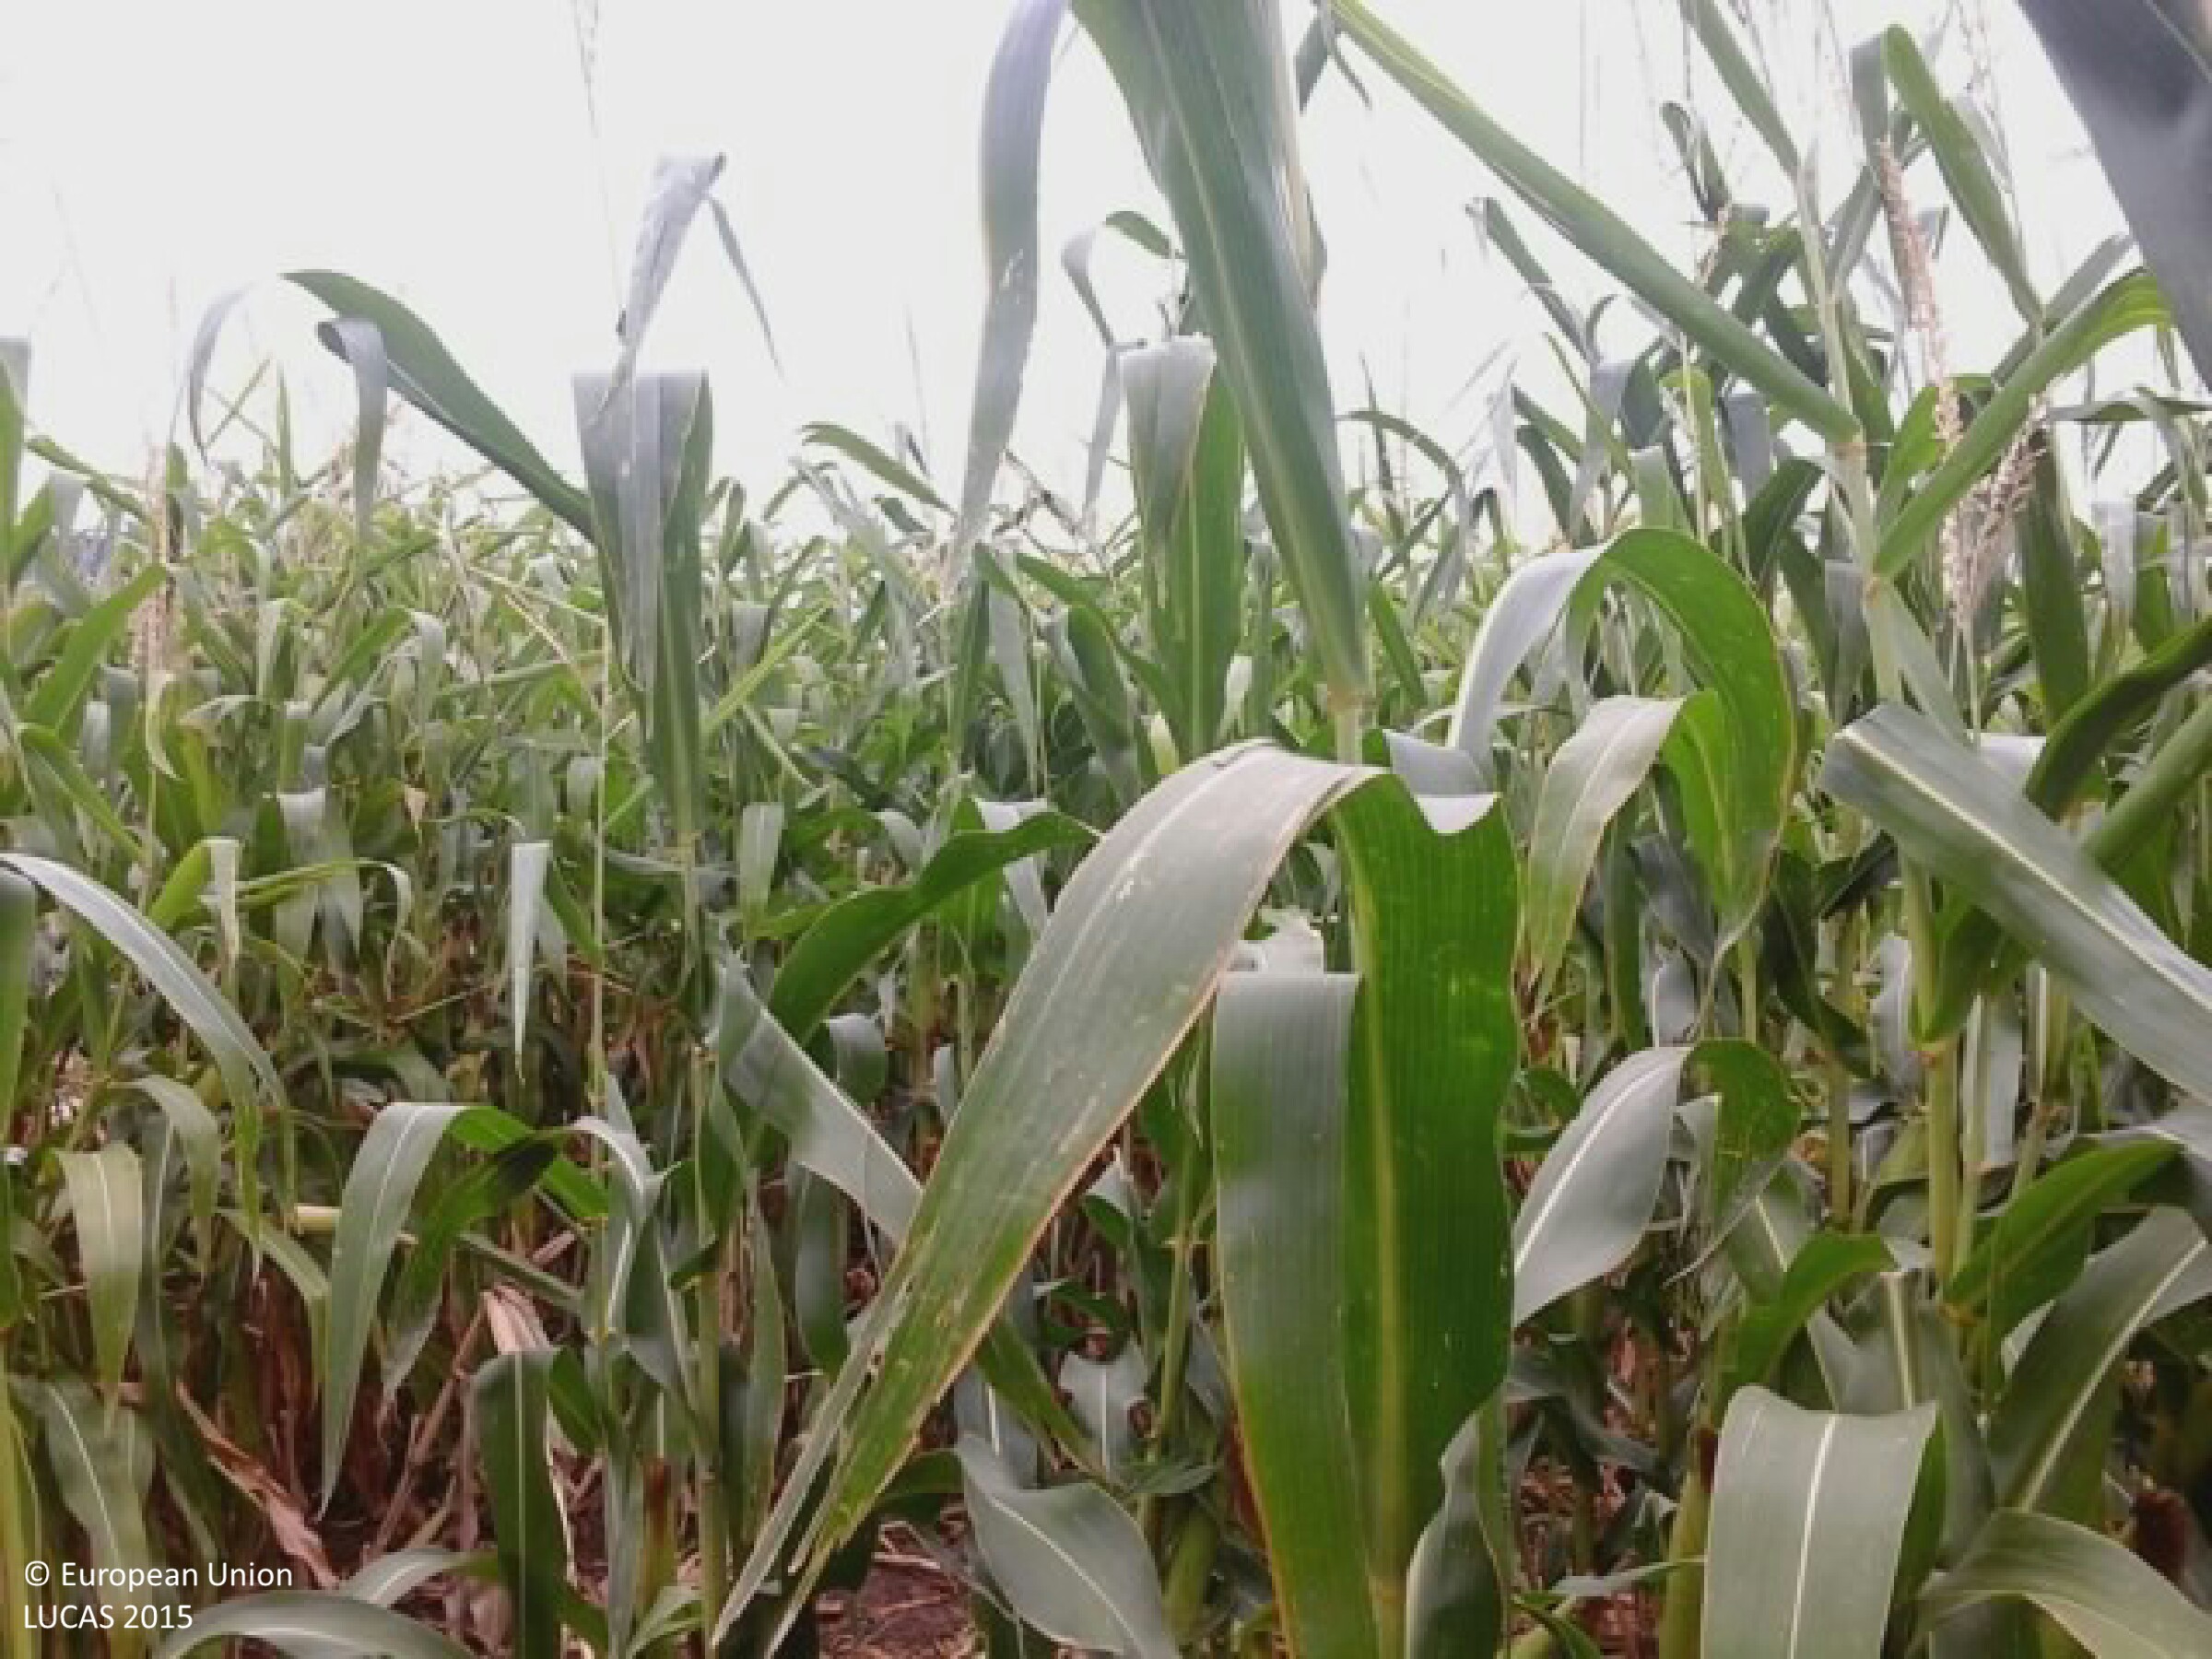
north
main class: Cropland
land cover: Maize
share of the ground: > 75 %
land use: Agriculture (excluding fallow land and kitchen gardens)
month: July
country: HU
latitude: 46.1483
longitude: 18.3850
